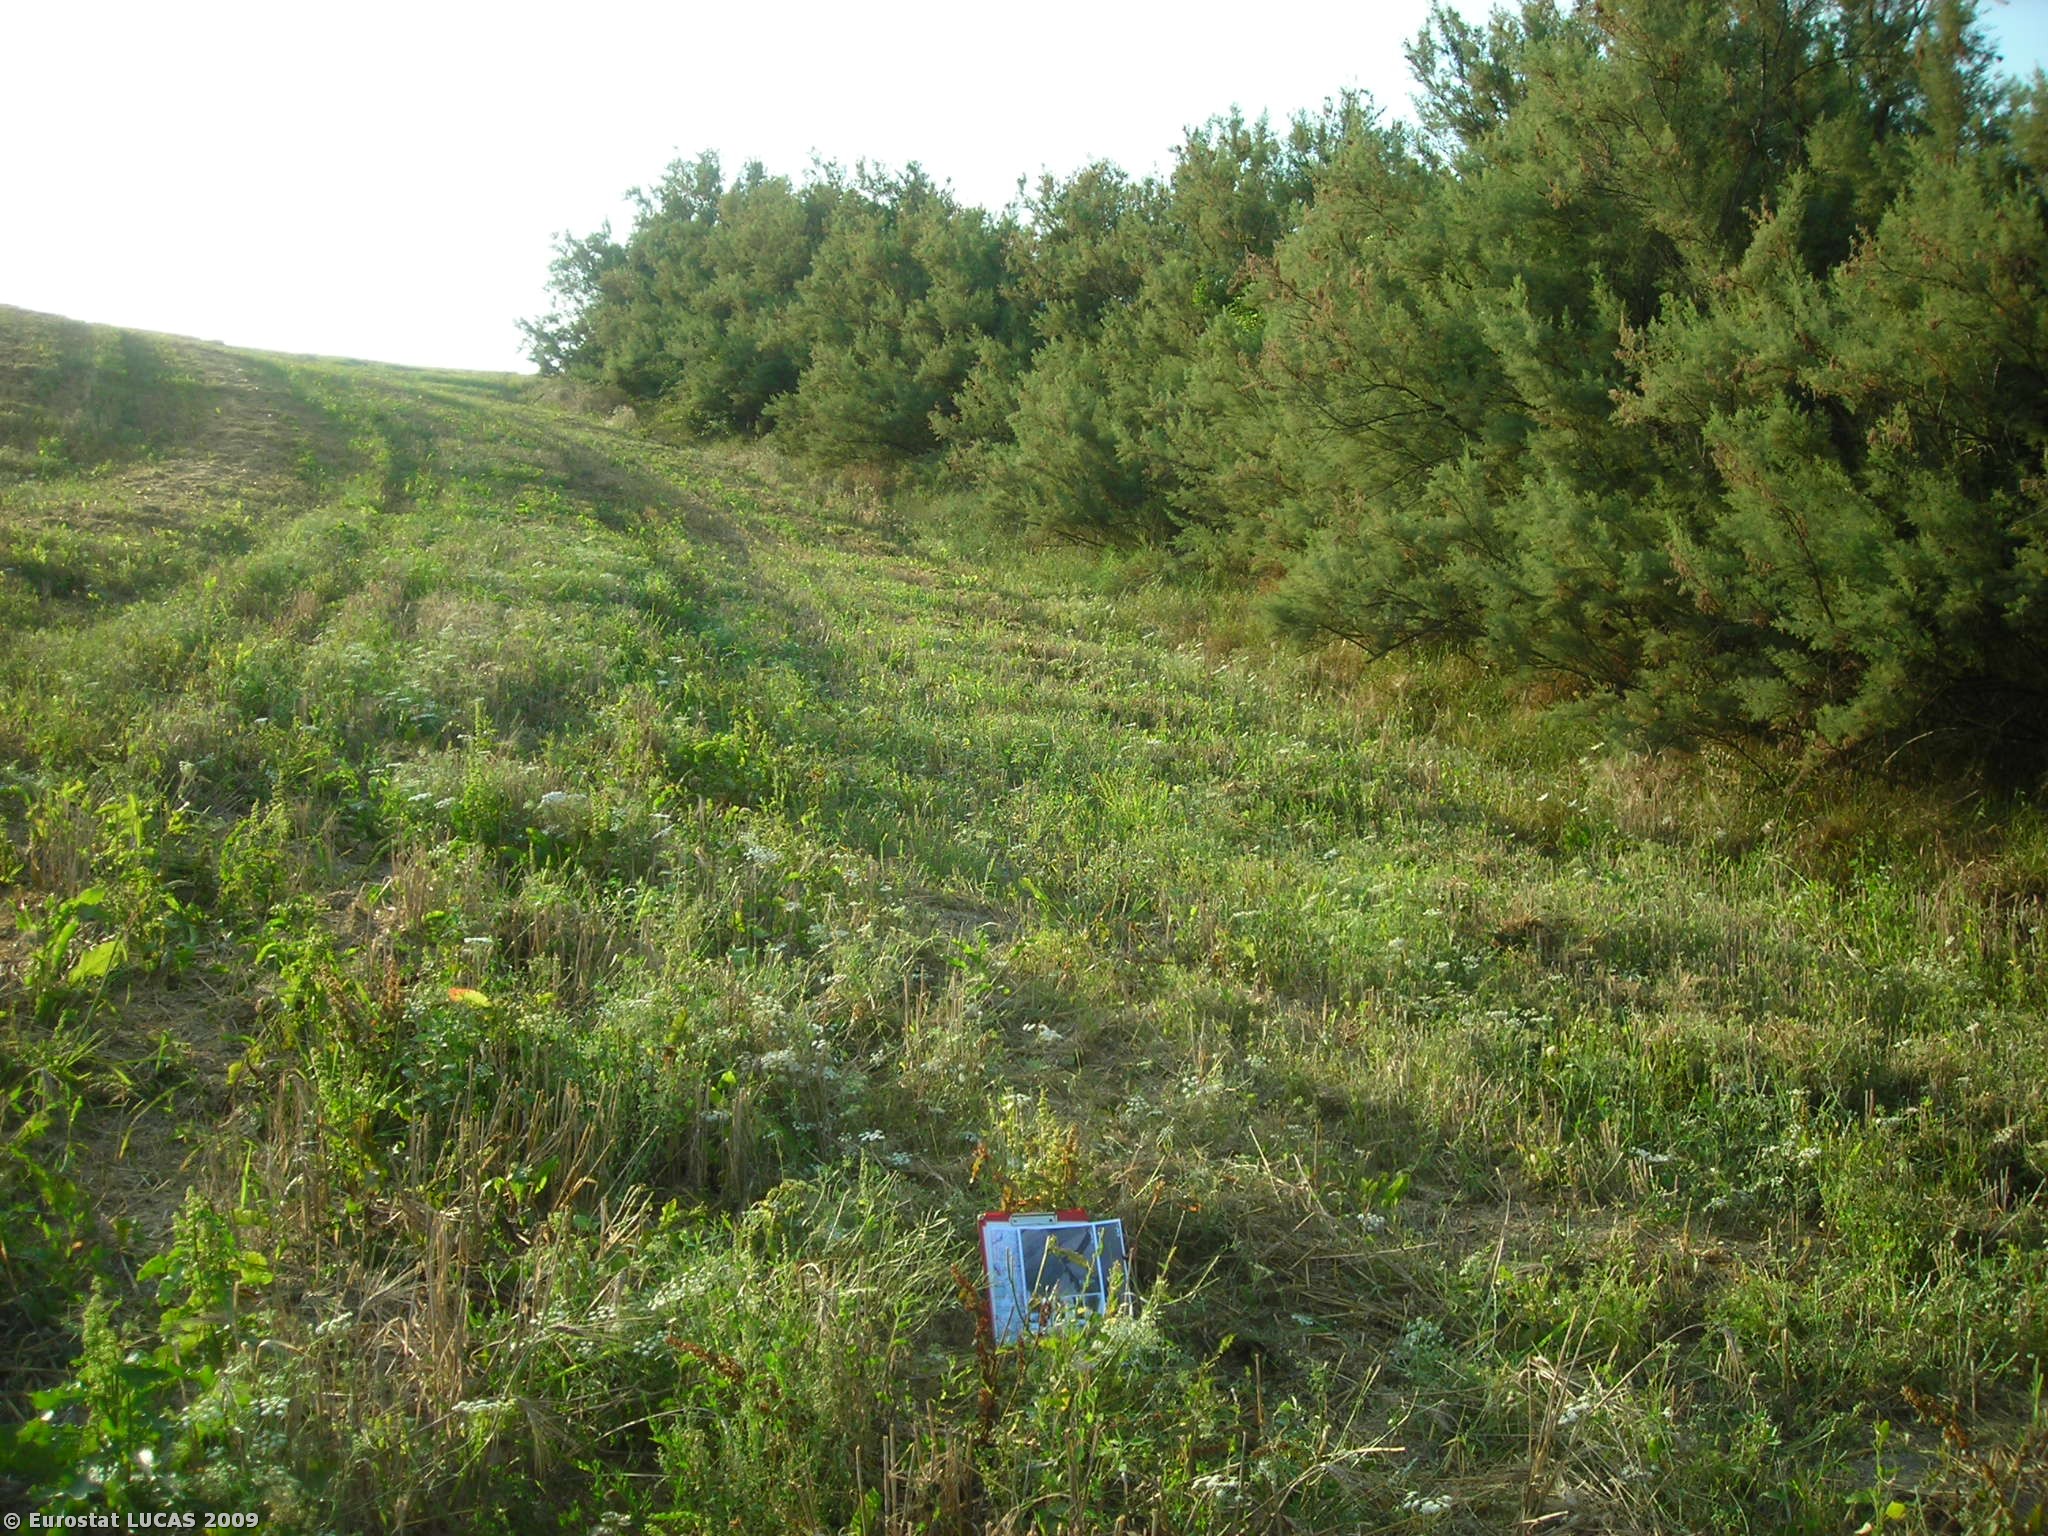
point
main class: Cropland
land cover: Durum wheat
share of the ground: < 10 %
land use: Agriculture (excluding fallow land and kitchen gardens)
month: July
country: IT
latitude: 43.3776
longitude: 13.2871
